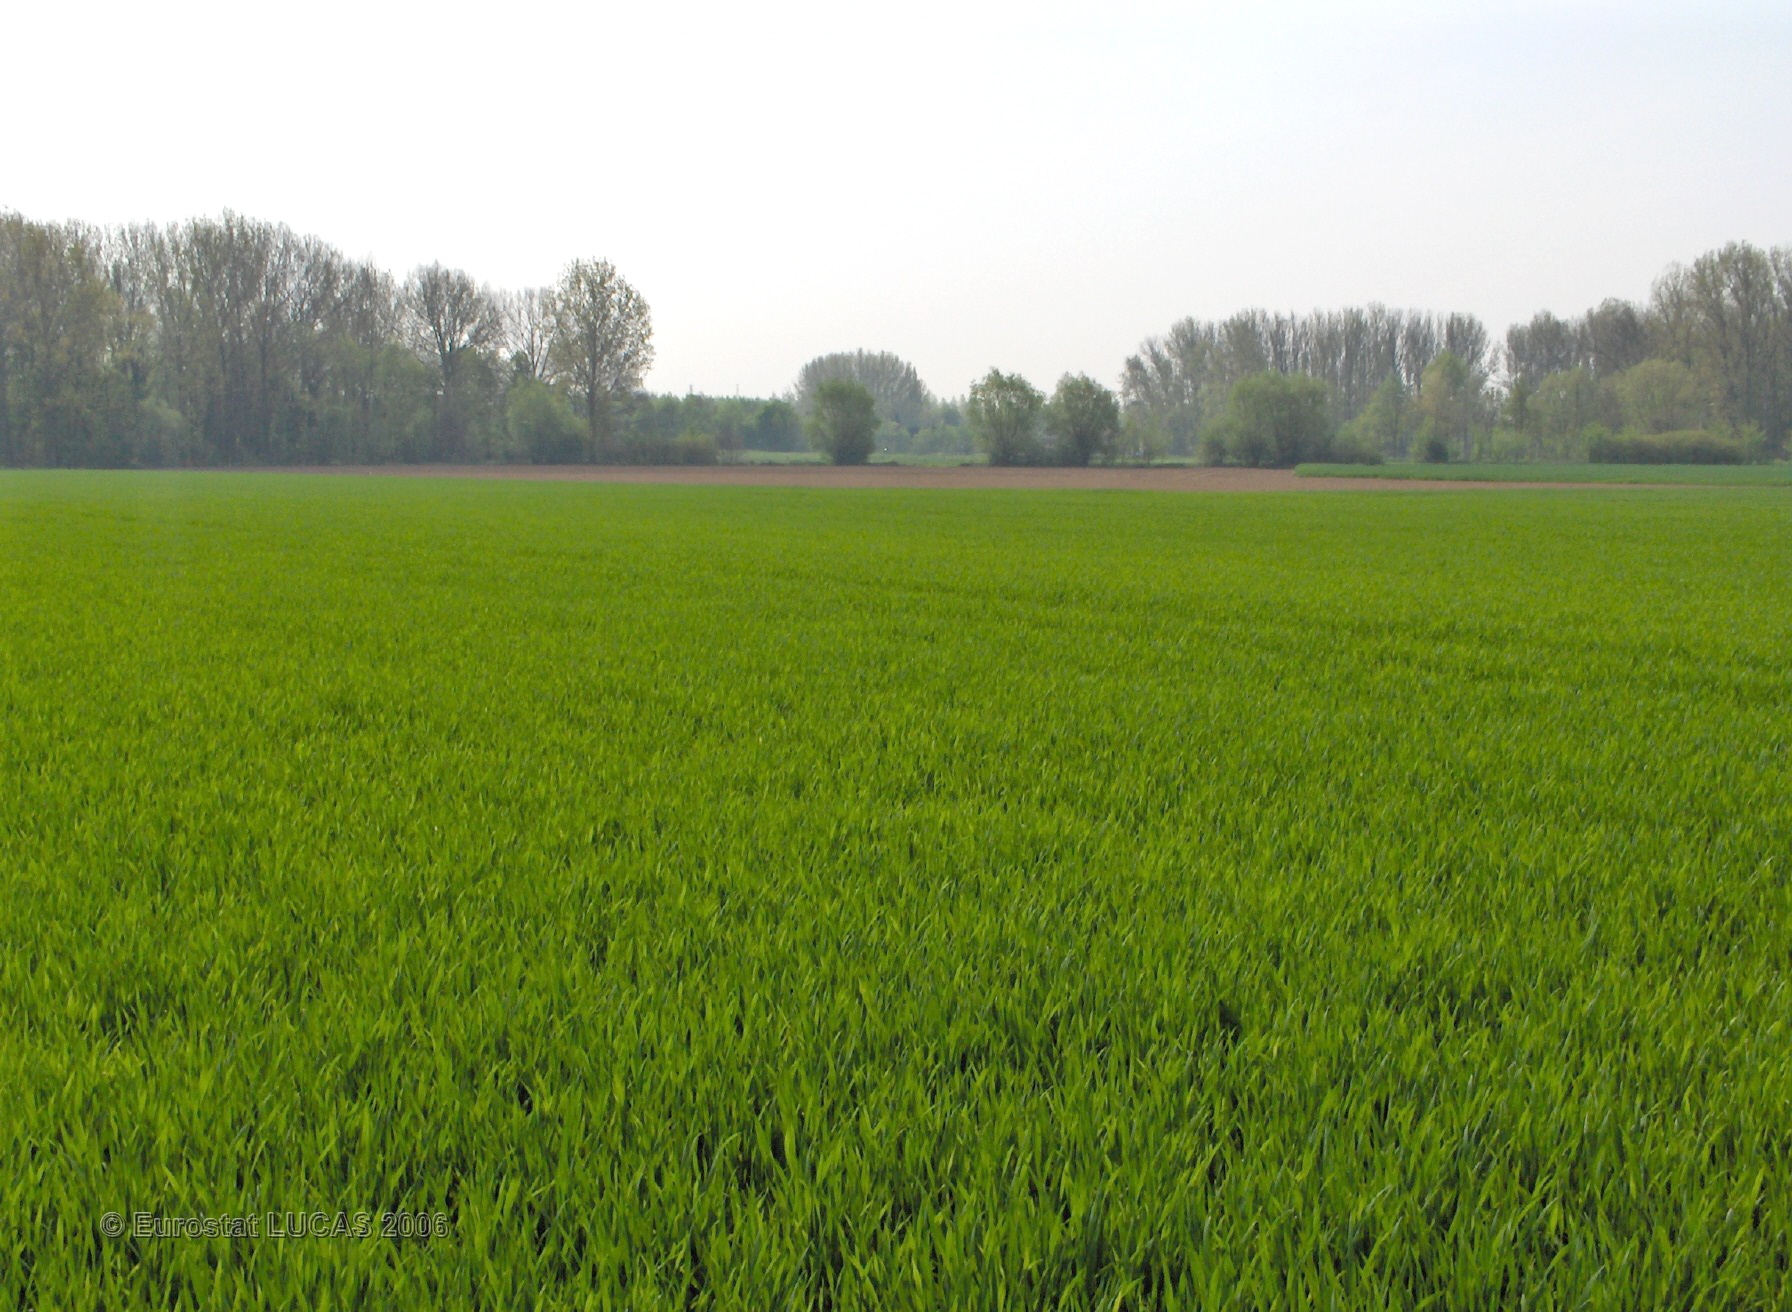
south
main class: Cropland
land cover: Common wheat
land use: Agriculture (excluding fallow land and kitchen gardens)
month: May
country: BE
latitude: 50.9699
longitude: 4.4846
